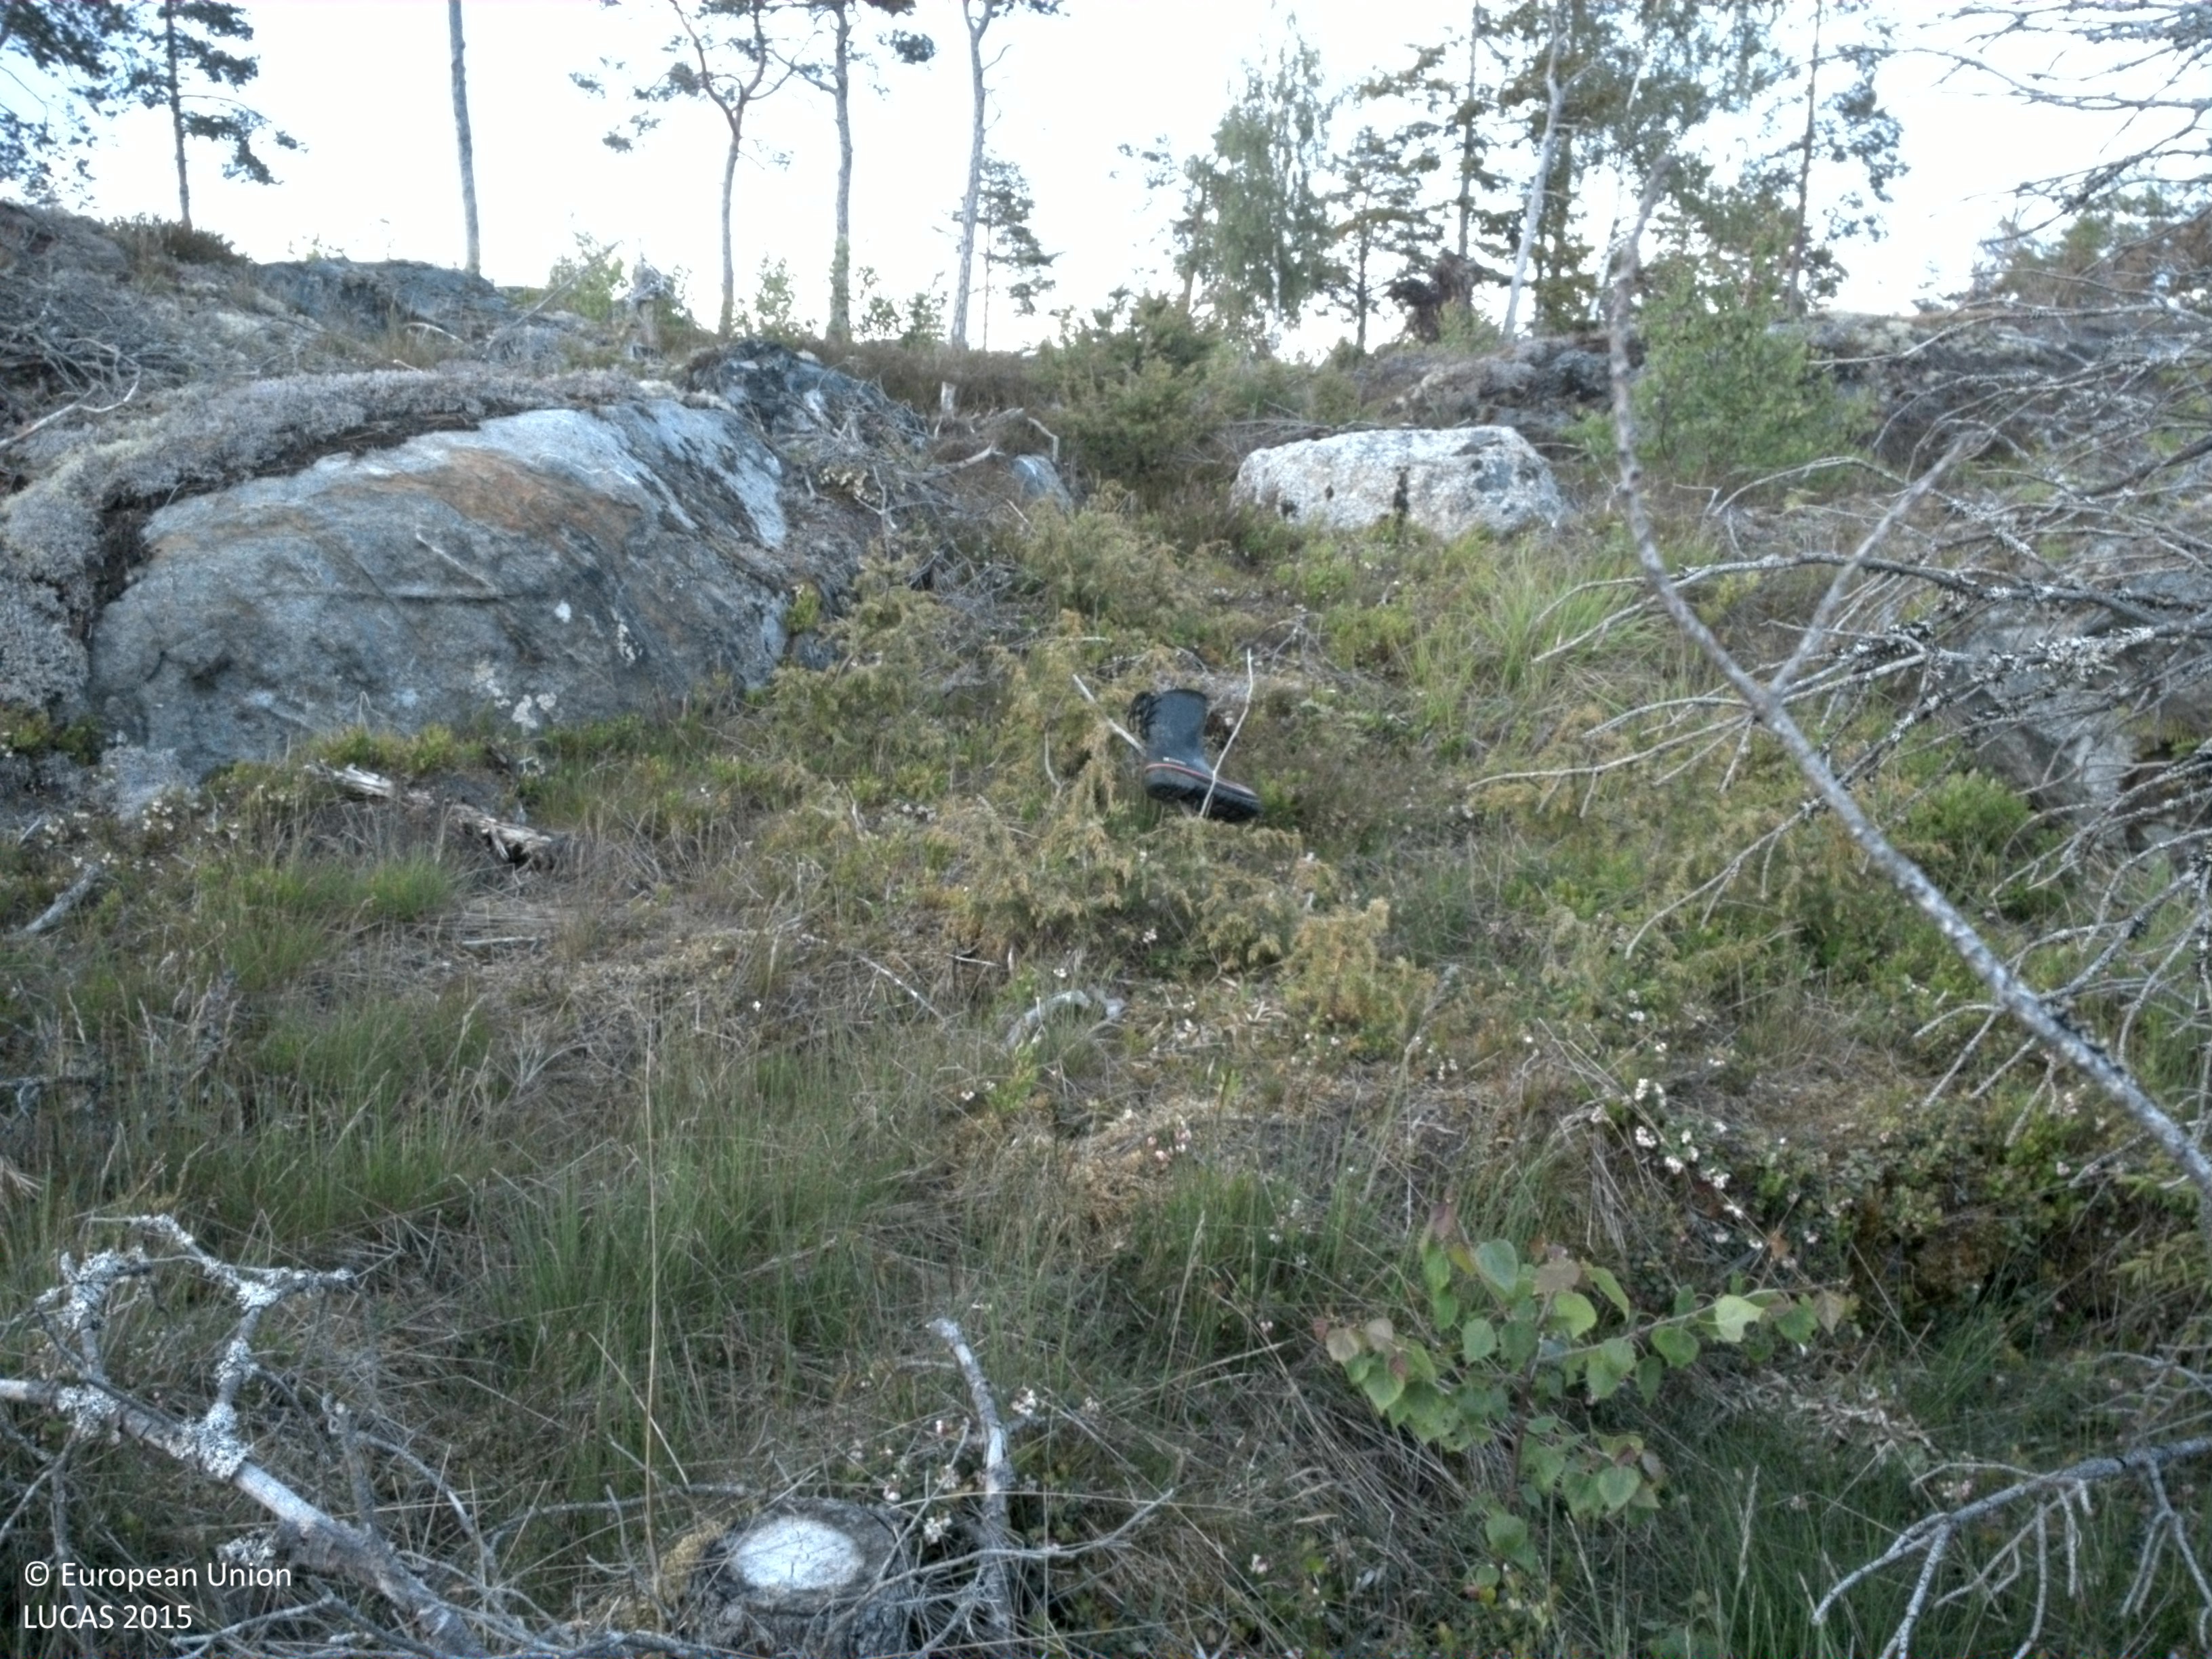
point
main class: Shrubland
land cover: Shrubland with sparse tree cover
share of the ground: 25 - 50 %
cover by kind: shrubs 35 %, consolidated bare surface 30 %, herbaceous plants 20 %, lichens and mosses 10 %, coniferous forest trees 5 %
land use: Forestry
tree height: > 5 m
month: June
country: SE
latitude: 60.0516
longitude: 18.7805
